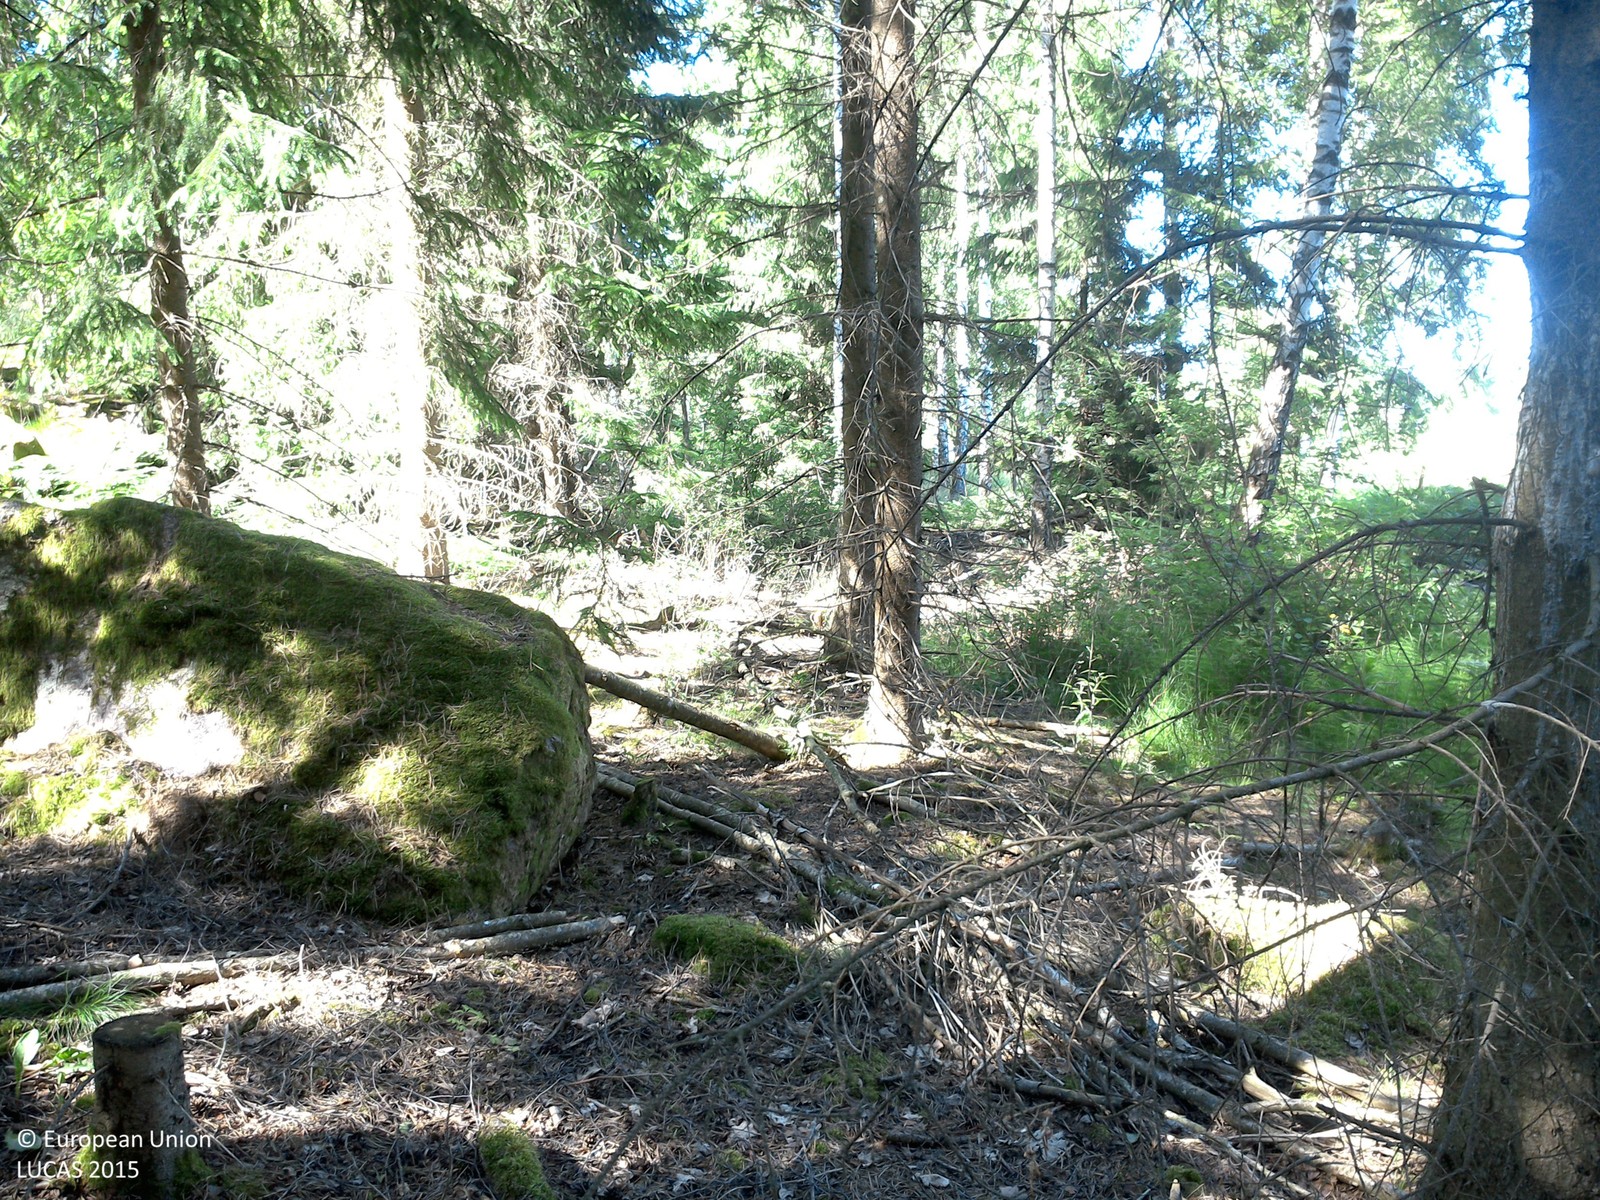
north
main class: Woodland
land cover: Spruce dominated coniferous woodland
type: boreal forest
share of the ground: > 75 %
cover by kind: coniferous forest trees 75 %, lichens and mosses 20 %, herbaceous plants 5 %
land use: Forestry
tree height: > 5 m
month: July
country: SE
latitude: 58.3451
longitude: 15.4101
